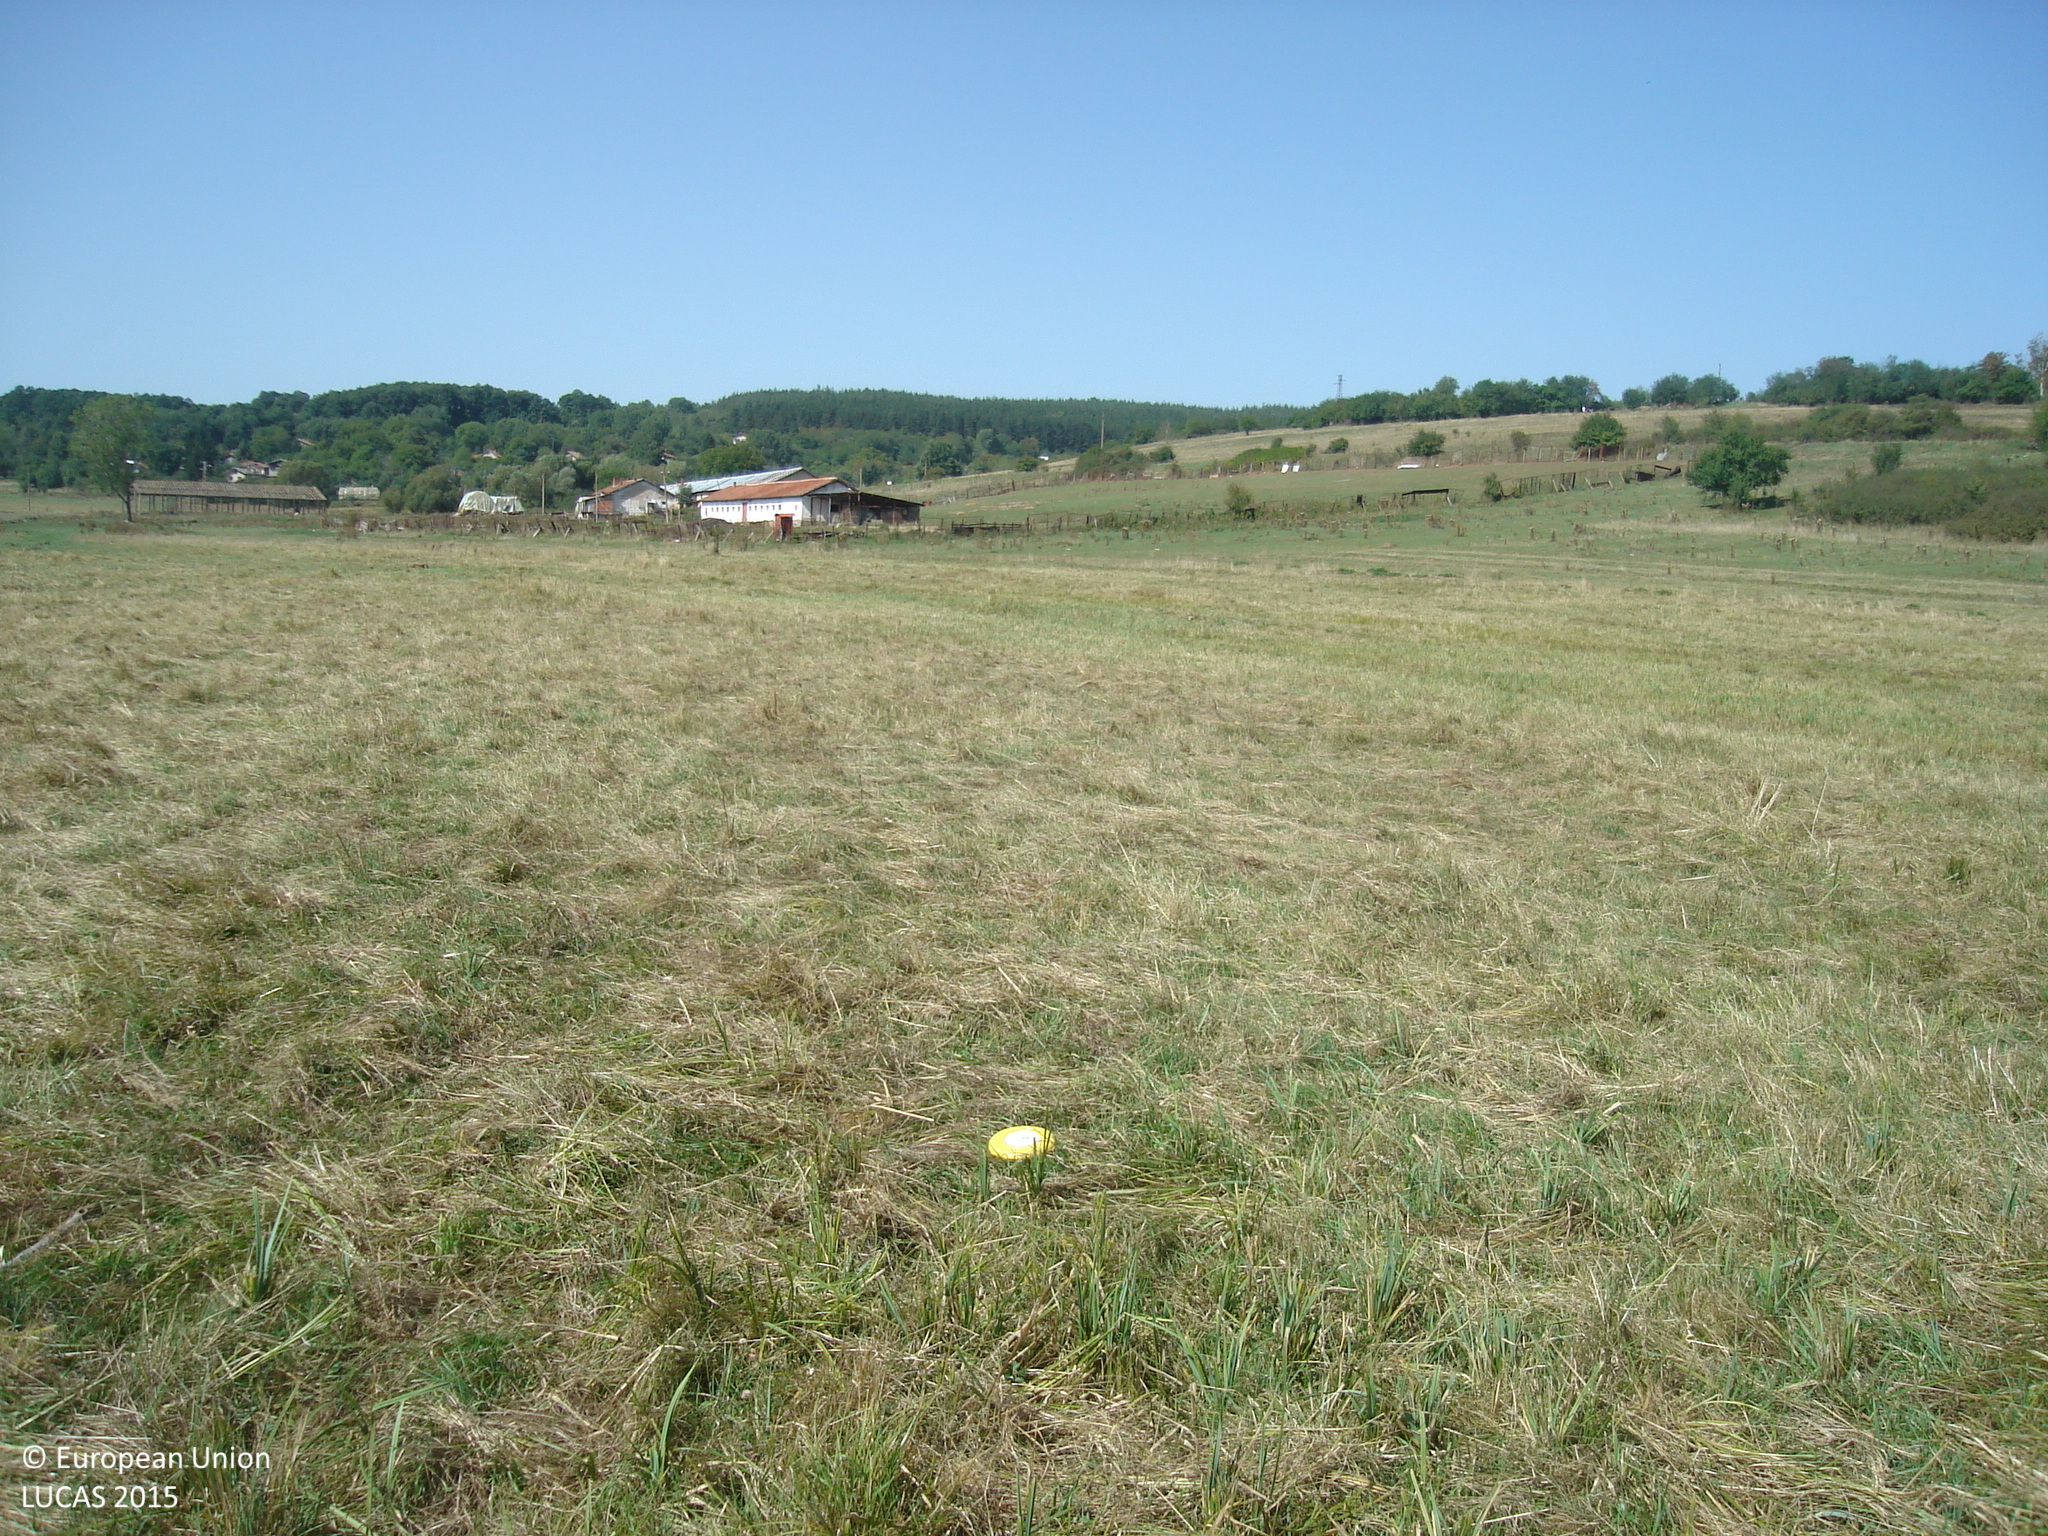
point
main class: Grassland
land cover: Grassland without tree/shrub cover
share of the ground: > 75 %
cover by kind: herbaceous plants 100 %
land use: Agriculture (excluding fallow land and kitchen gardens)
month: September
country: BG
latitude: 42.9485
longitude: 23.1114
